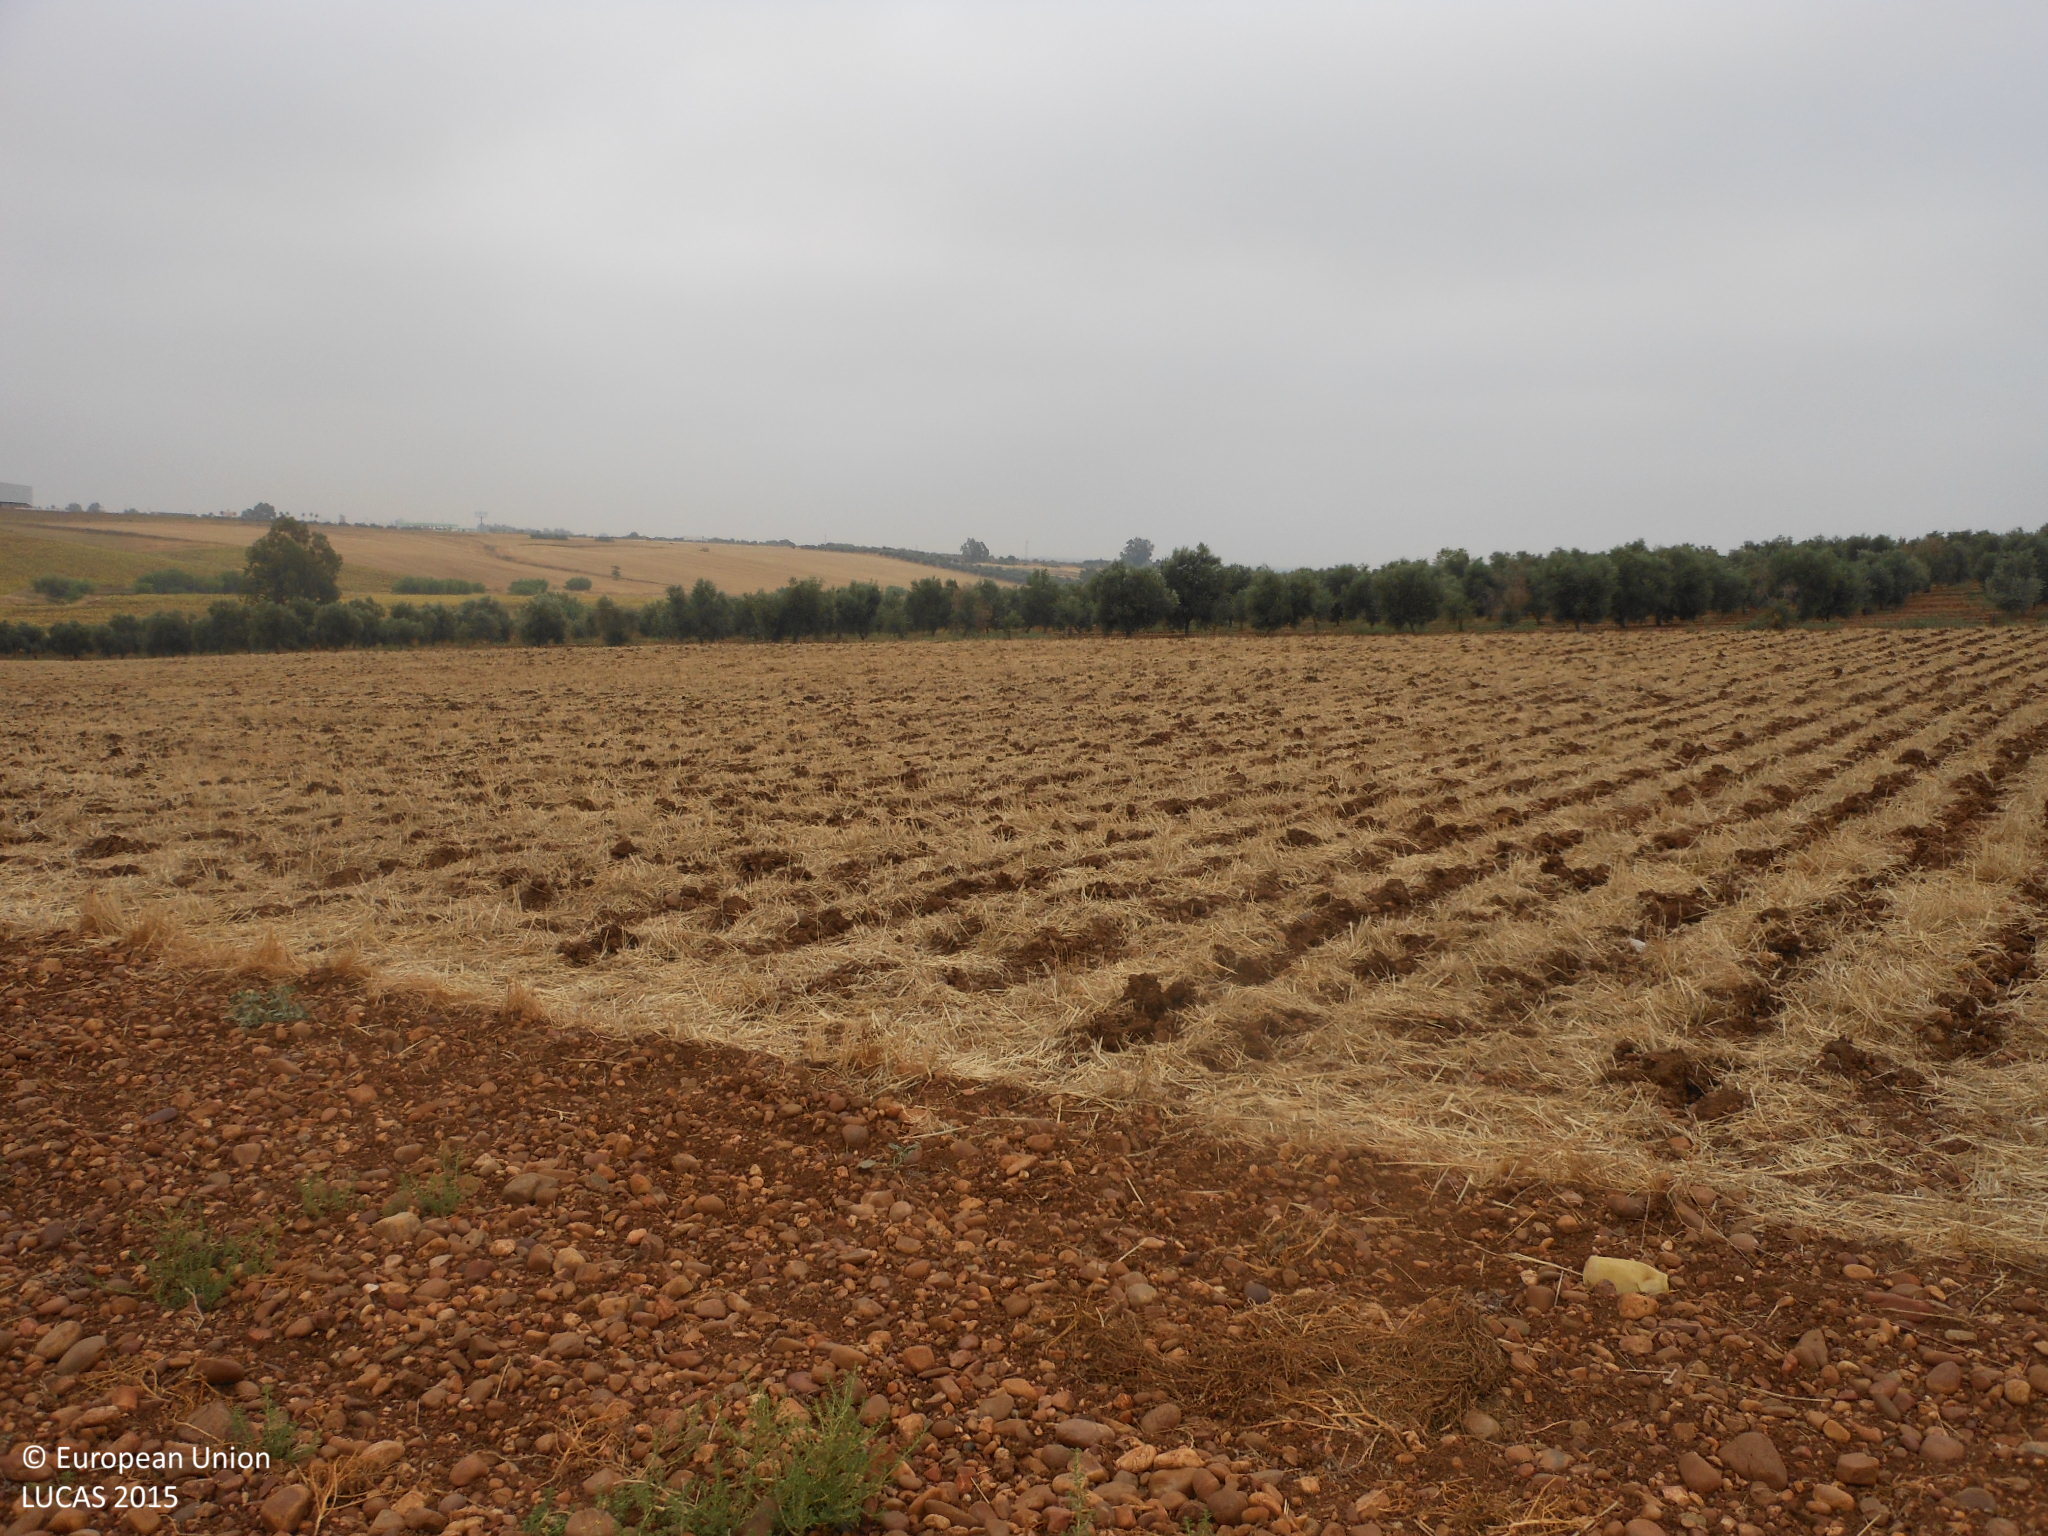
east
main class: Cropland
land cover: Sunflower
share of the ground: > 75 %
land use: Agriculture (excluding fallow land and kitchen gardens)
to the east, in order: Sunflower; Olive groves; Other bare soil; Olive groves
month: June
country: ES
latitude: 37.6602
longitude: -4.9650
